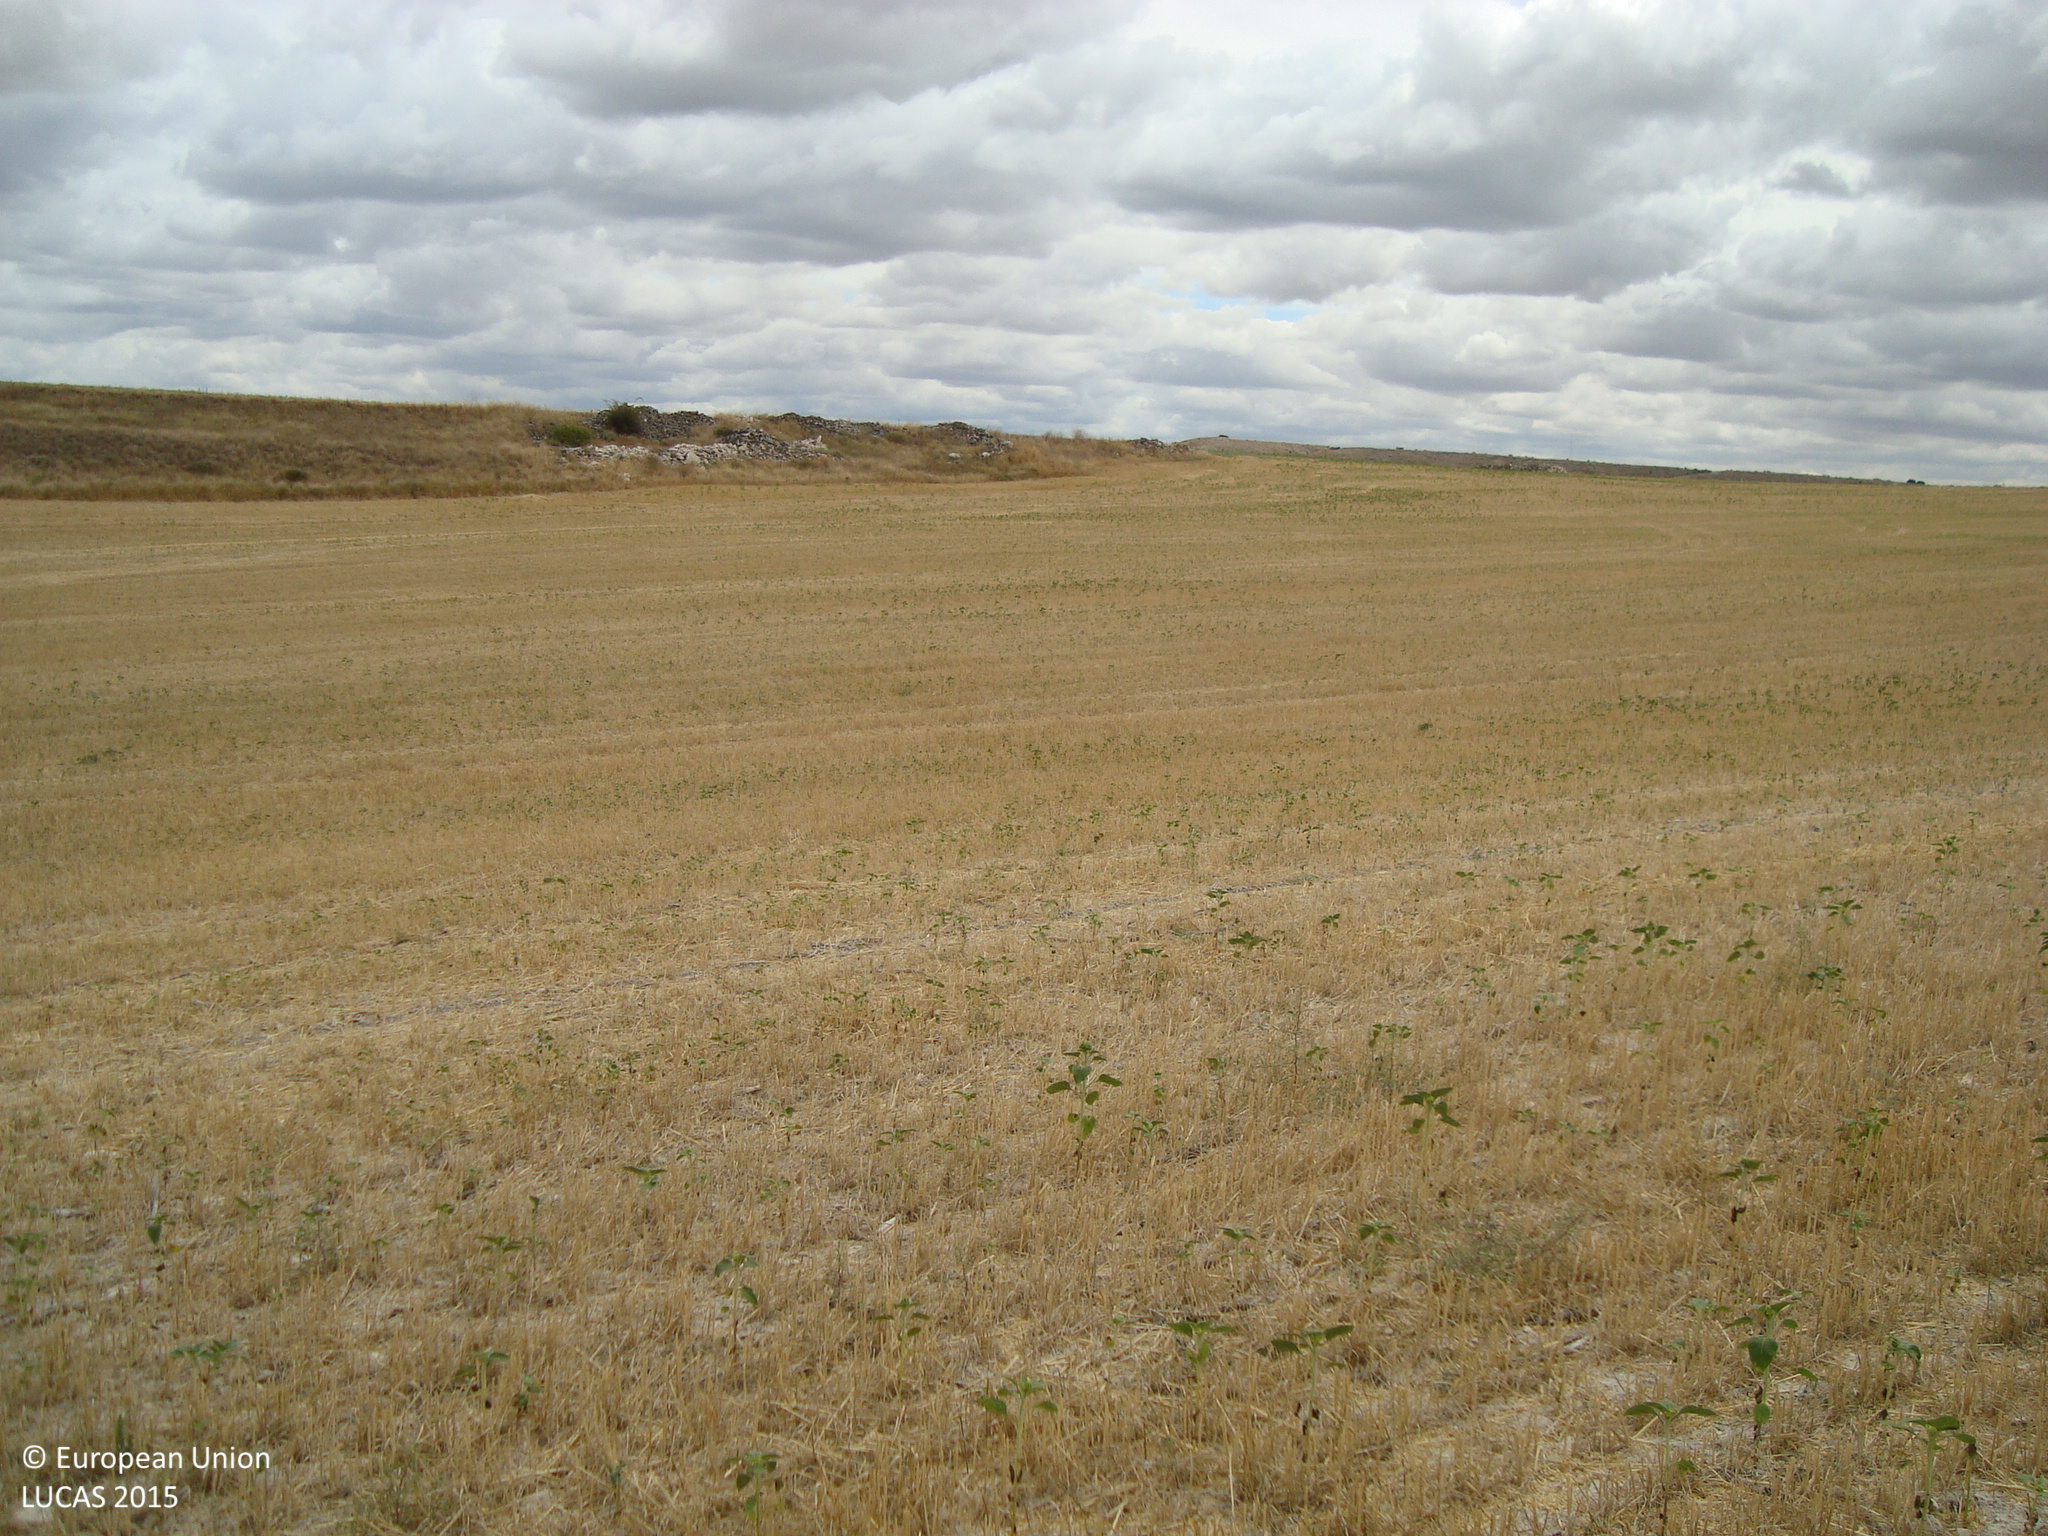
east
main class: Cropland
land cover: Common wheat
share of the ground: > 75 %
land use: Agriculture (excluding fallow land and kitchen gardens)
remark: Harvested field
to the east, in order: Common wheat; Groves; Grassland without tree/shrub cover; Barley
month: August
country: ES
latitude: 42.0622
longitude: -4.1183
